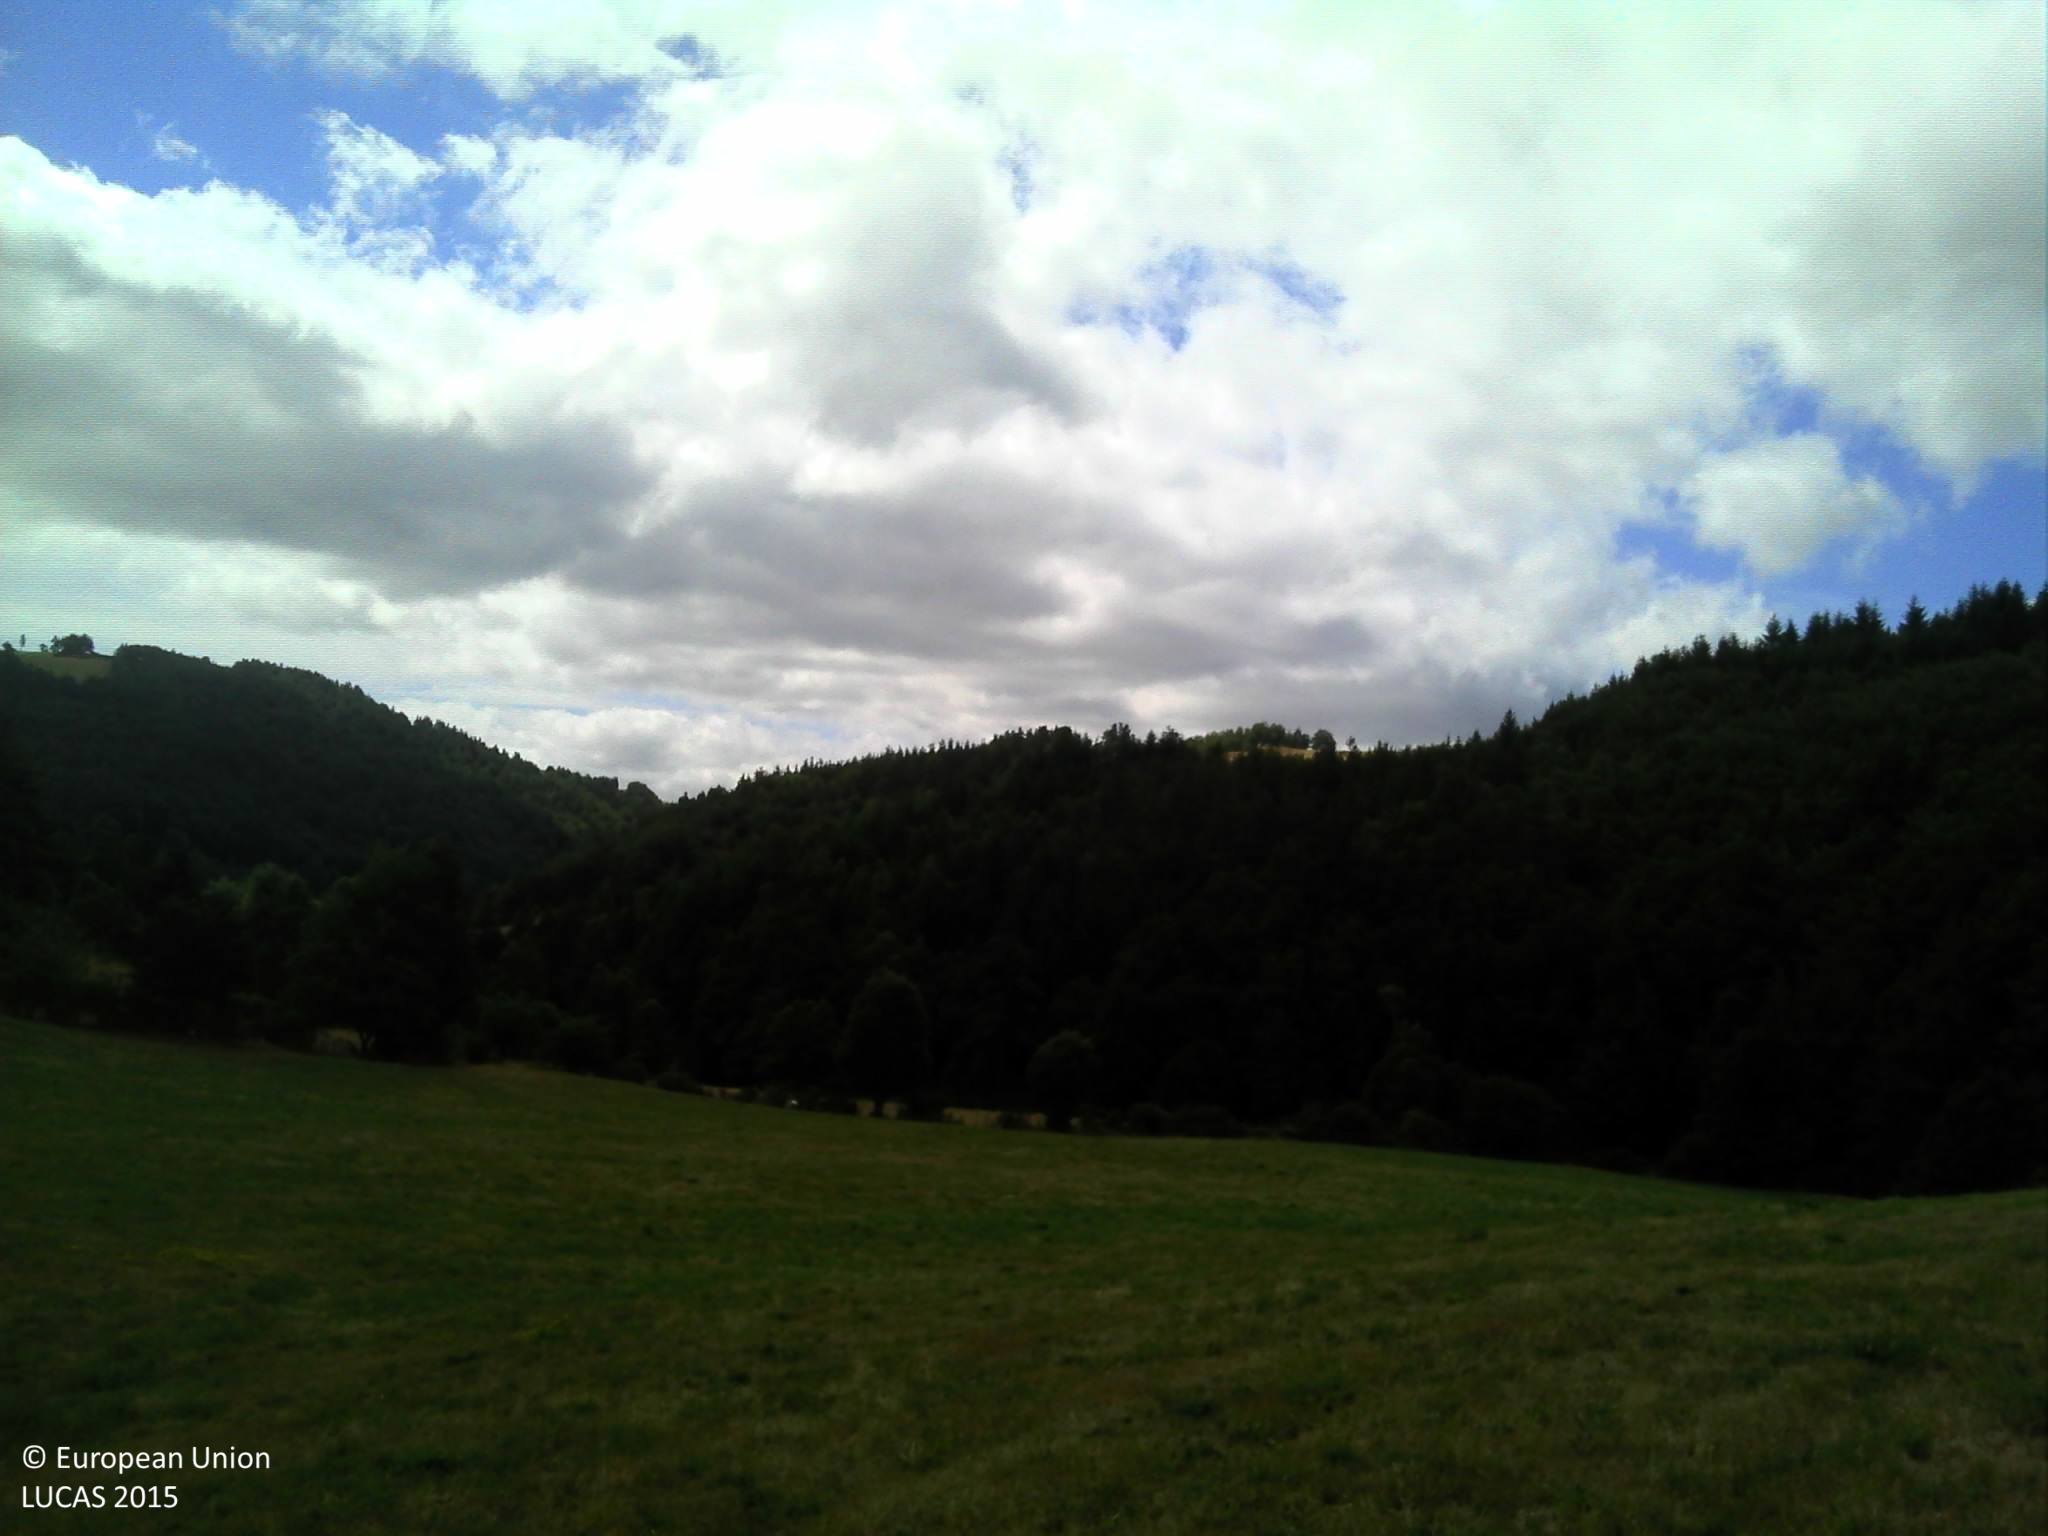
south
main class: Grassland
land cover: Grassland without tree/shrub cover
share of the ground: > 75 %
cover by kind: herbaceous plants 100 %
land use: Agriculture (excluding fallow land and kitchen gardens)
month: July
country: FR
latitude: 44.6395
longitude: 3.2847
